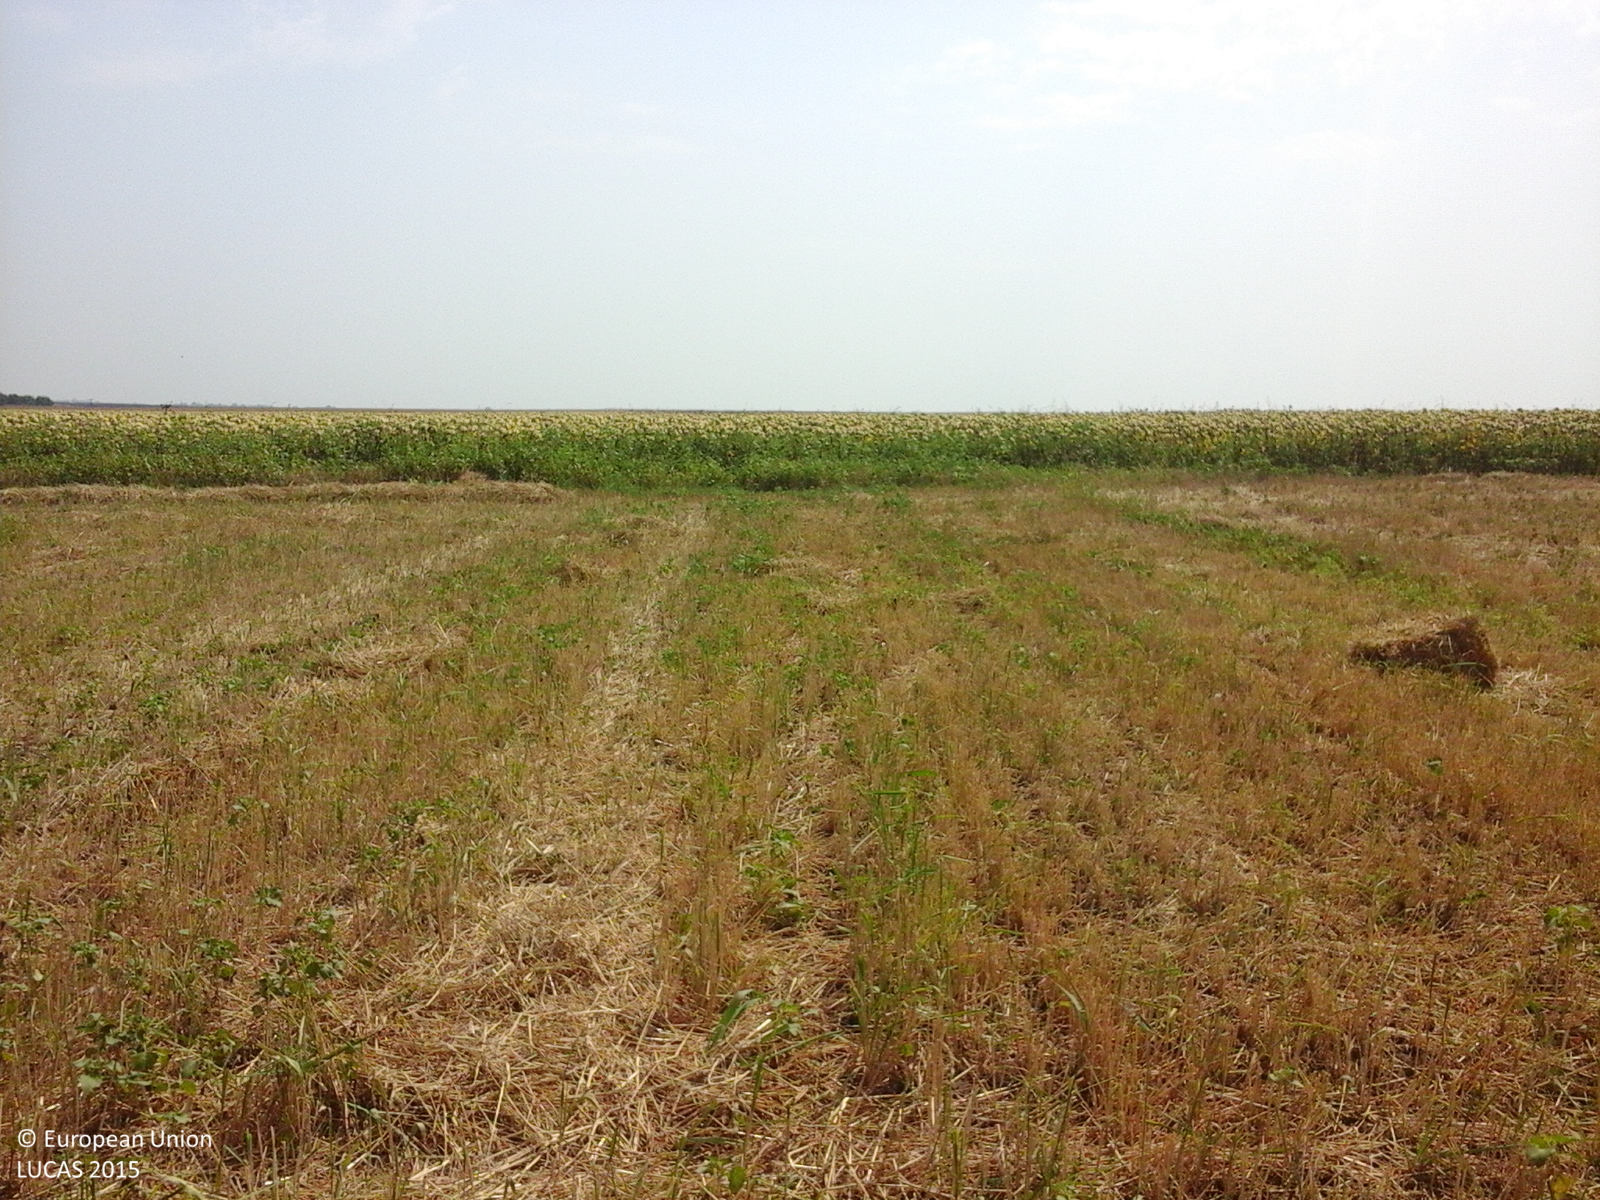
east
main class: Cropland
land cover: Common wheat
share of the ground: > 75 %
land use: Agriculture (excluding fallow land and kitchen gardens)
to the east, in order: Common wheat; Sunflower
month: August
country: RO
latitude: 43.8833
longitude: 23.2247
